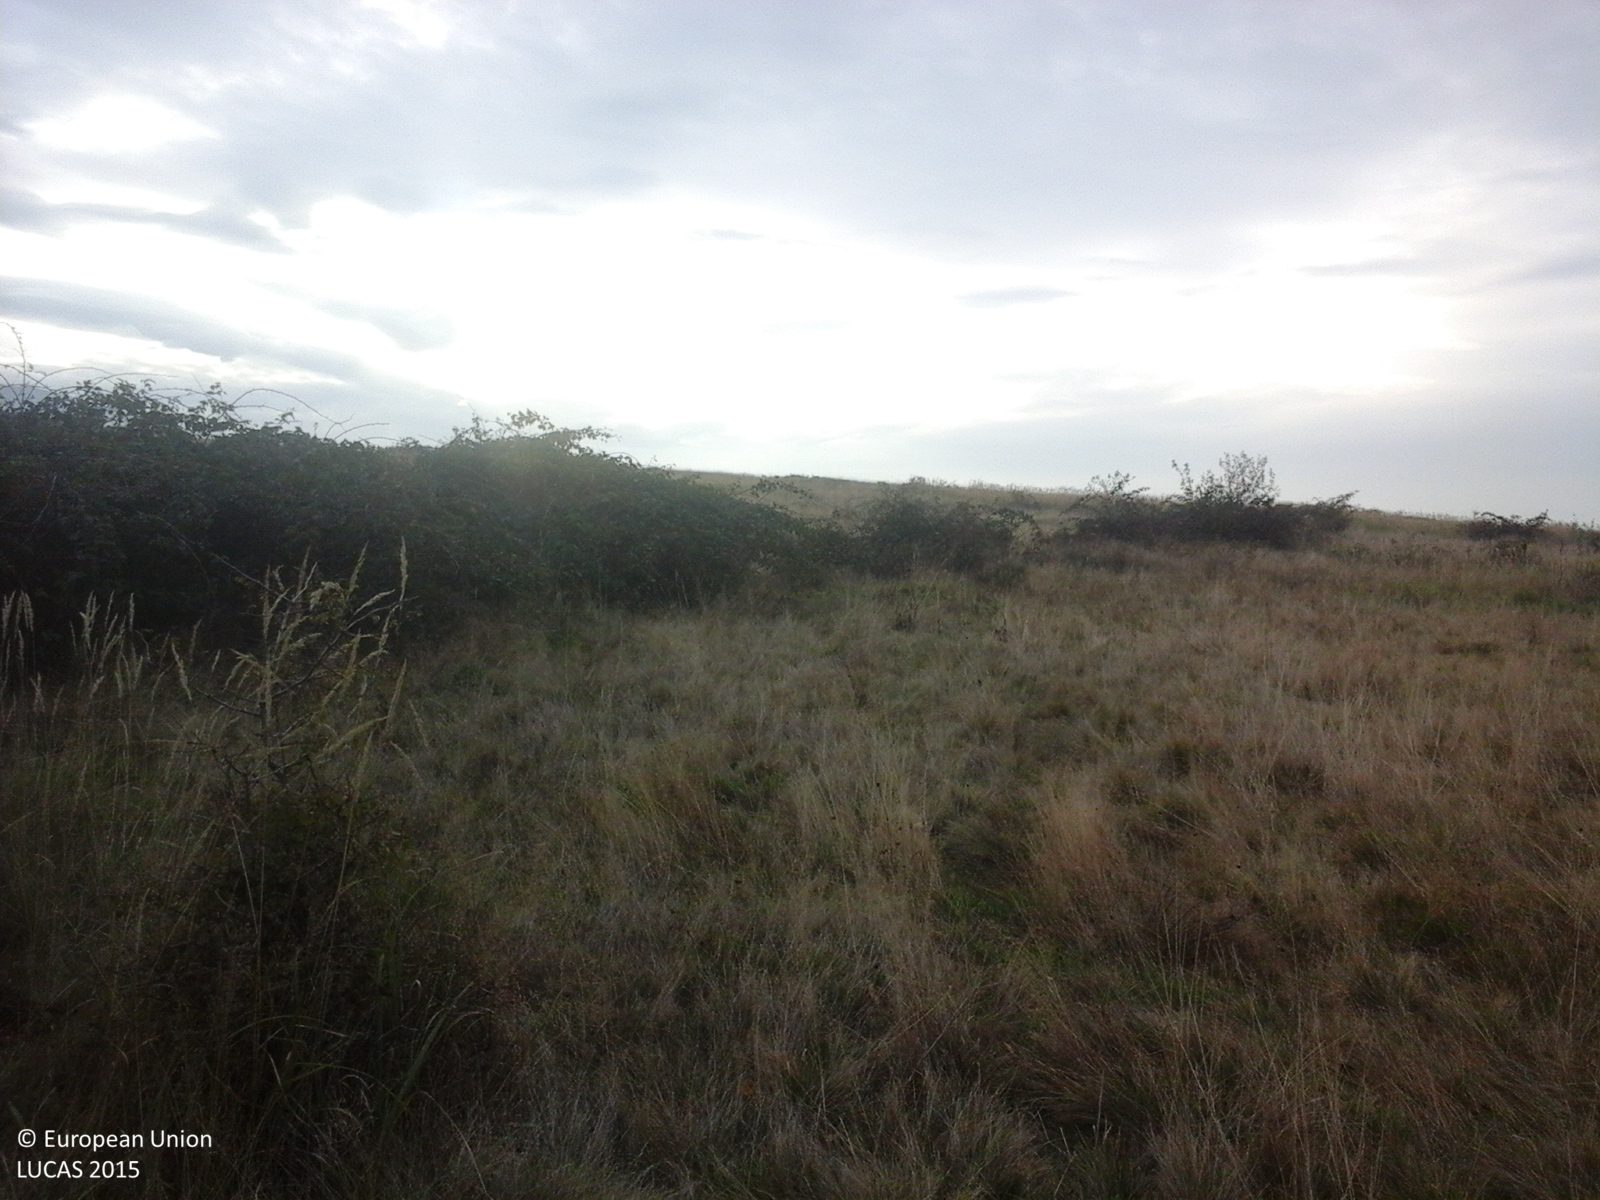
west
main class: Shrubland
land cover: Shrubland without tree cover
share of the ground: > 75 %
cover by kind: shrubs 100 %
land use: Semi-natural and natural areas not in use
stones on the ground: < 10 %
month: October
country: RO
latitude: 45.7096
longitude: 25.1101
